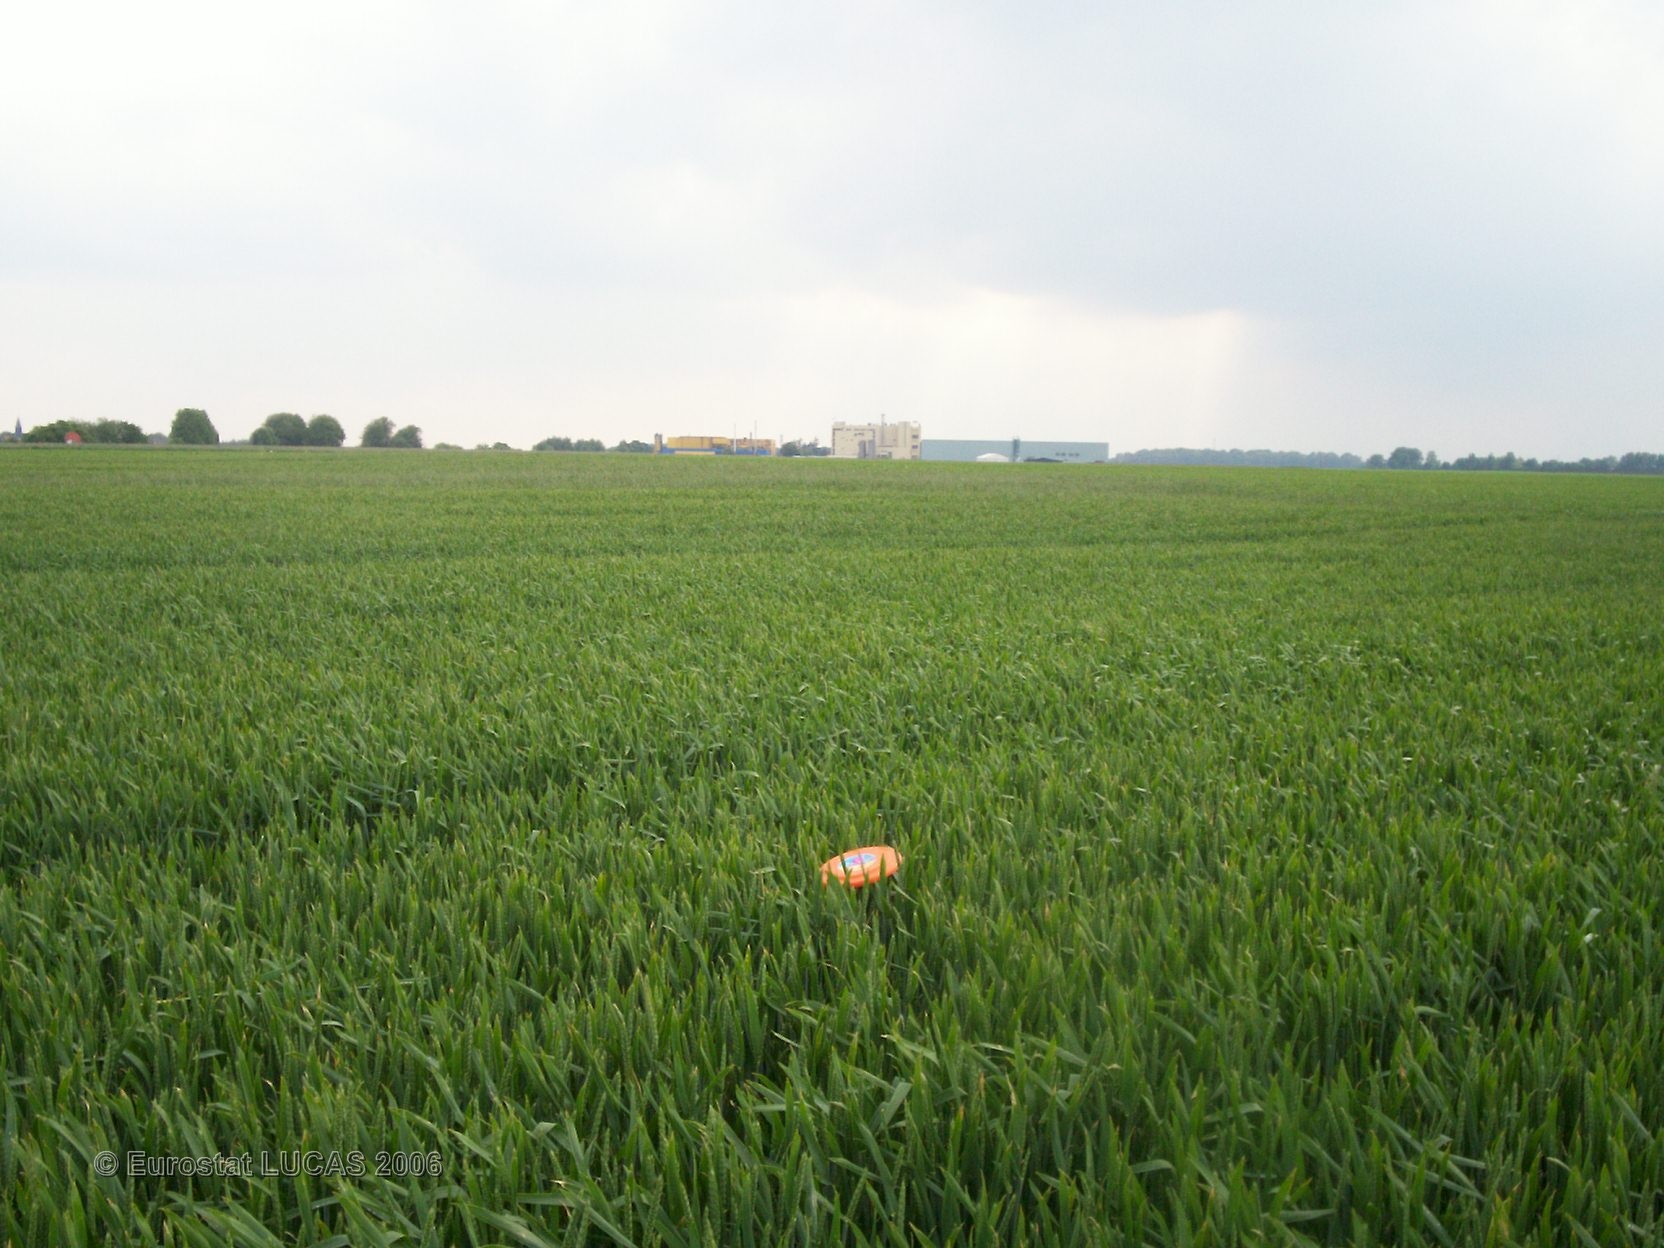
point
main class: Cropland
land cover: Common wheat
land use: Agriculture (excluding fallow land and kitchen gardens)
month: June
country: FR
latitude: 49.6568
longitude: 2.6329
